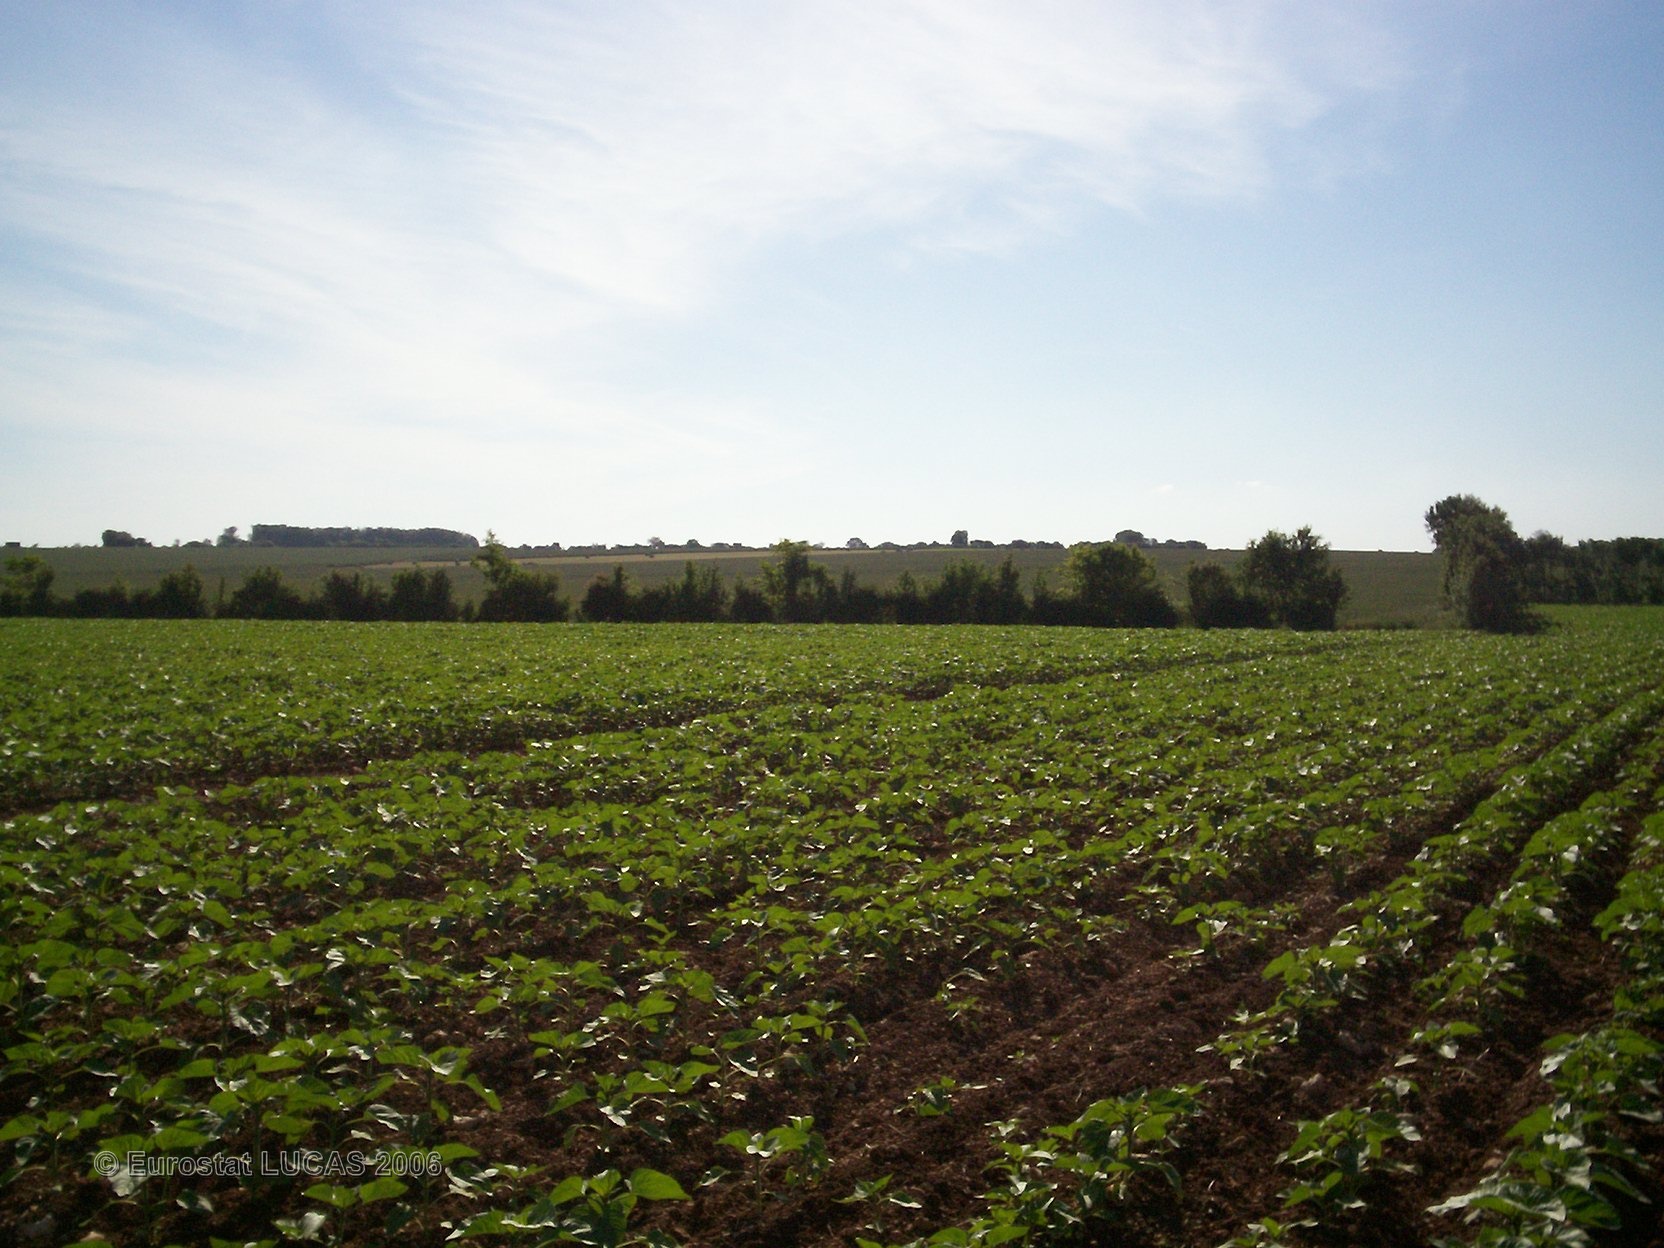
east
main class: Cropland
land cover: Sunflower
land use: Agriculture (excluding fallow land and kitchen gardens)
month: April
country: FR
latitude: 46.0858
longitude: -0.6958
